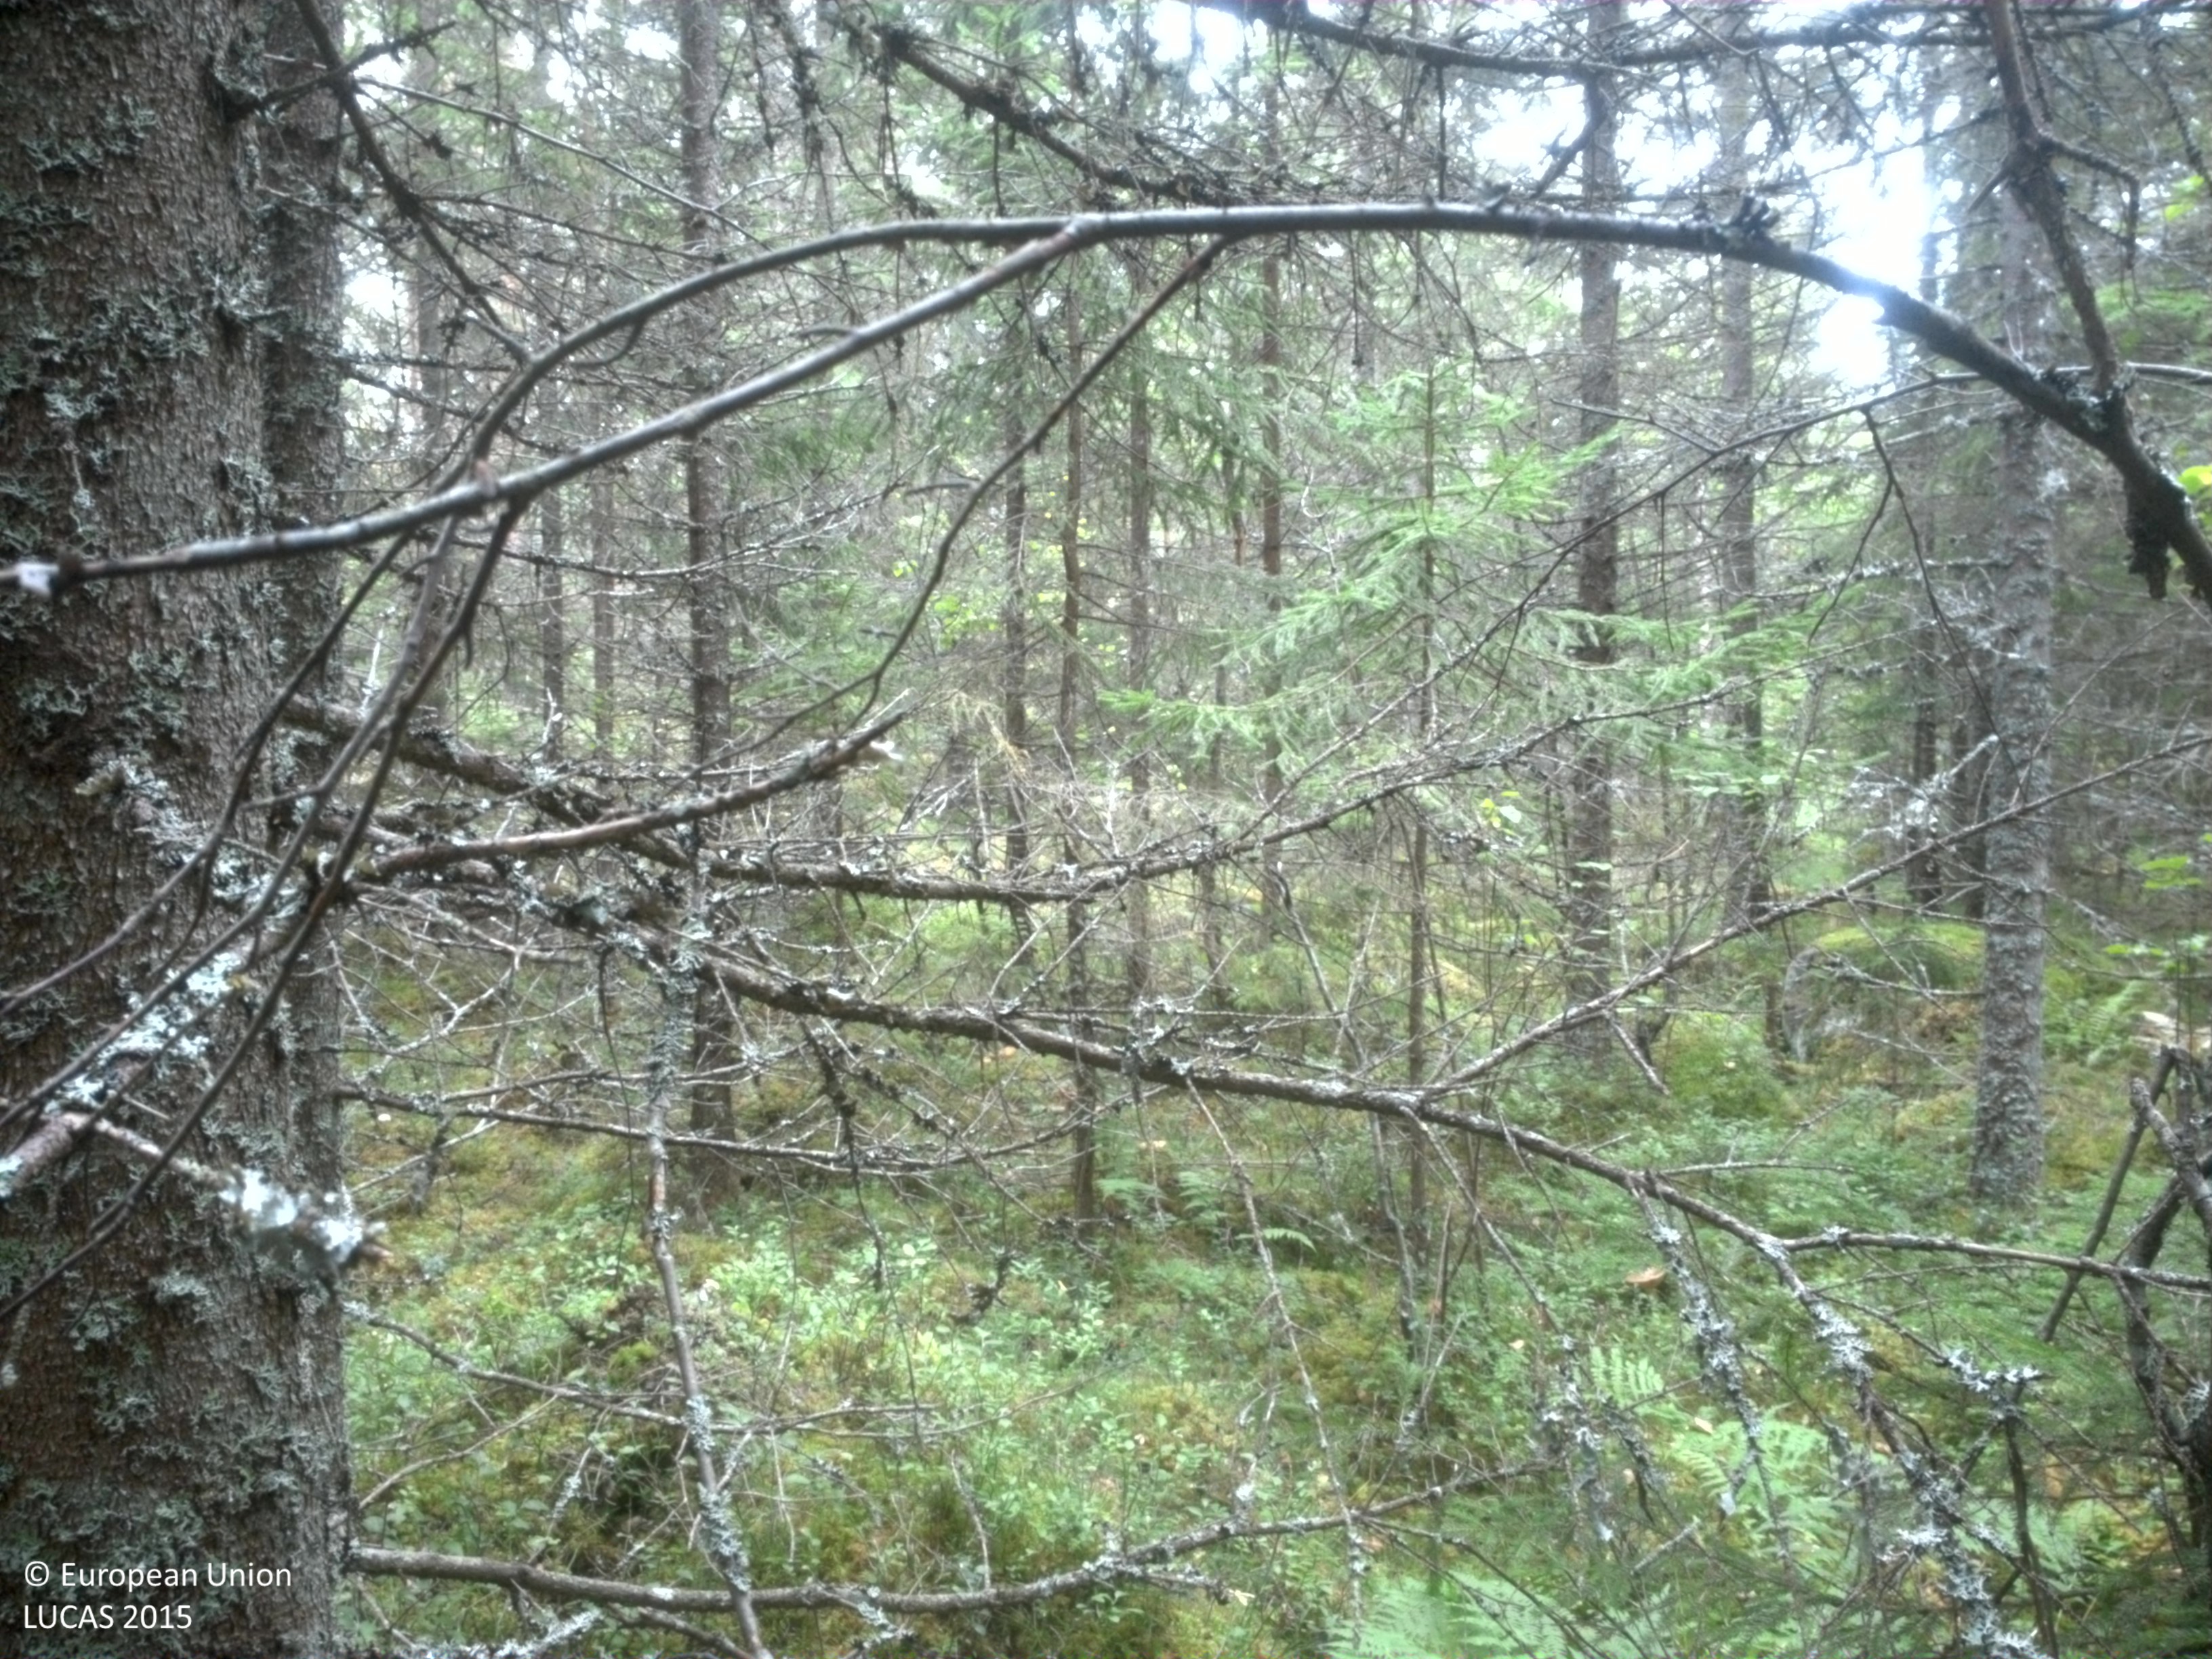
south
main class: Woodland
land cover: Spruce dominated coniferous woodland
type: boreal forest
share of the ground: > 75 %
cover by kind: coniferous forest trees 70 %, lichens and mosses 15 %, shrubs 10 %, broadleaved forest trees 5 %
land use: Forestry
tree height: > 5 m
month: August
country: SE
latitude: 59.7212
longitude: 15.7337
